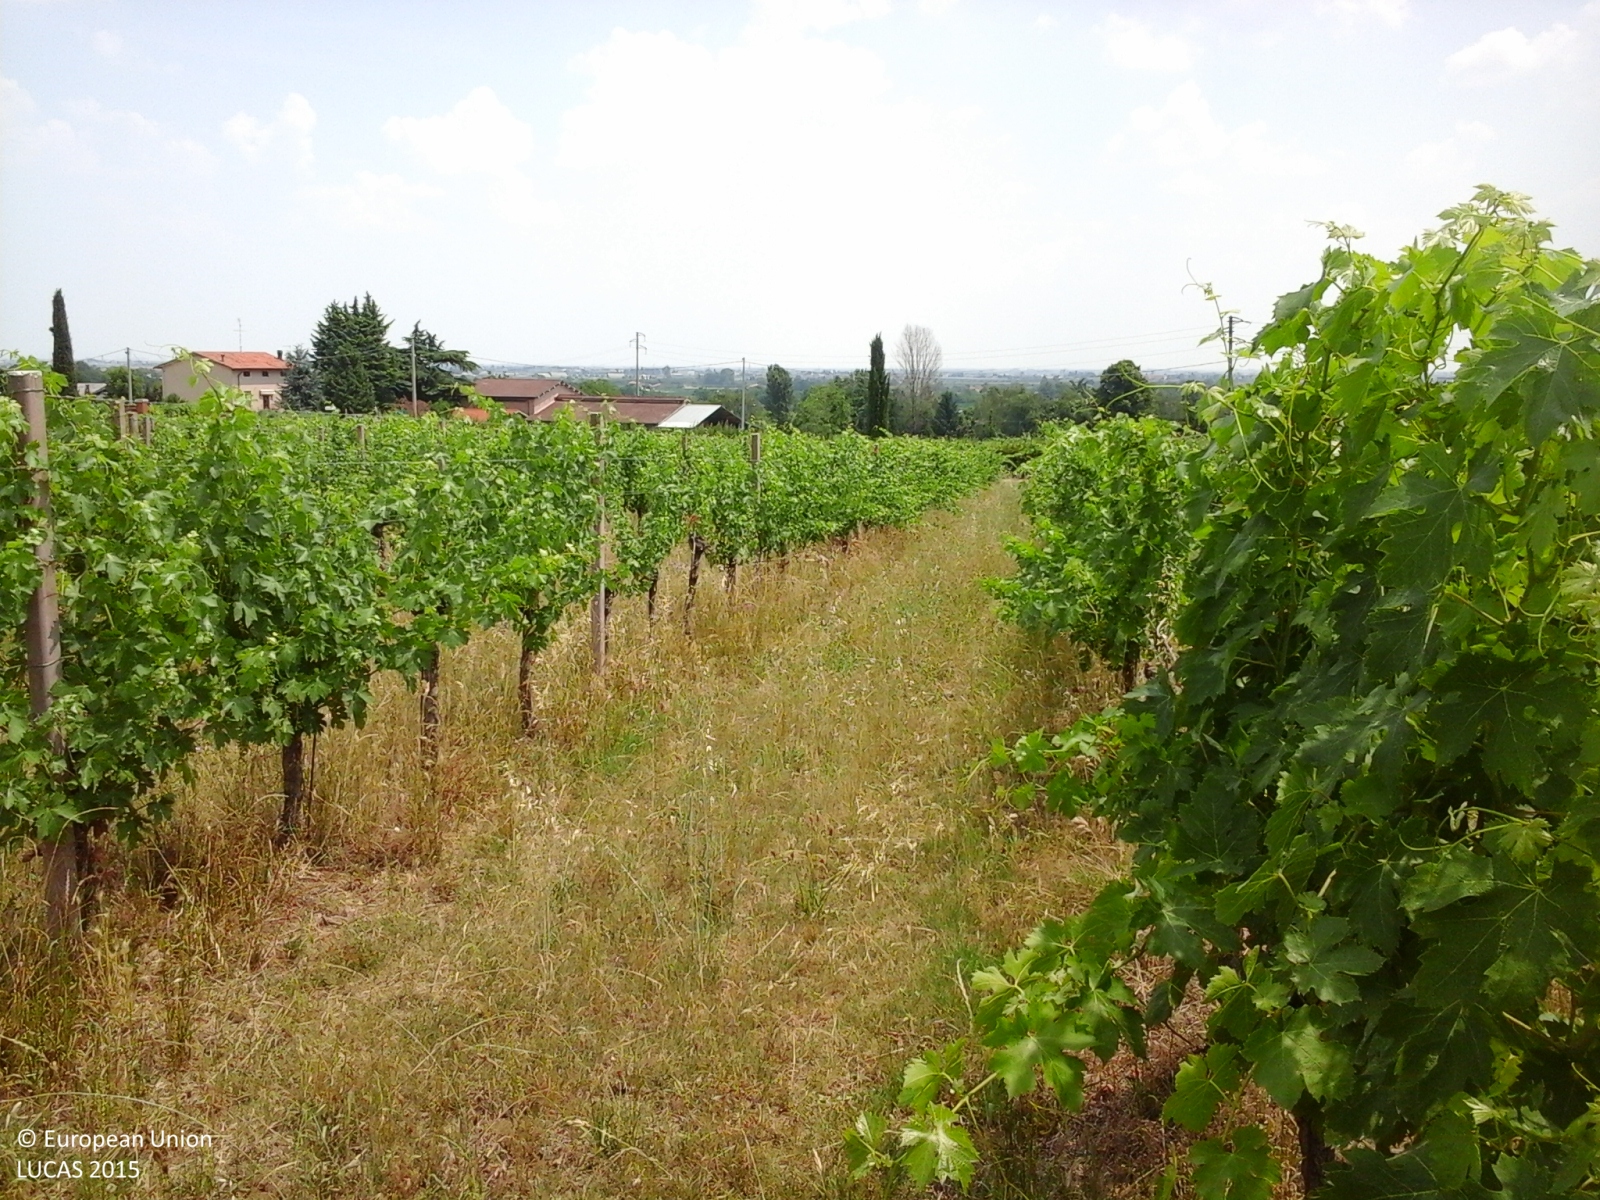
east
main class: Cropland
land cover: Vineyards
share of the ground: 25 - 50 %
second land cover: Grassland without tree/shrub cover
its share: > 75 %
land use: Agriculture (excluding fallow land and kitchen gardens)
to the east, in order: Vineyards; Grassland without tree/shrub cover; Grass margins; Paved roads, cycling and walking lanes; Grass margins; Vineyards; Grass margins; Artificial constructions in urban areas
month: June
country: IT
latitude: 45.3930
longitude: 10.8288
